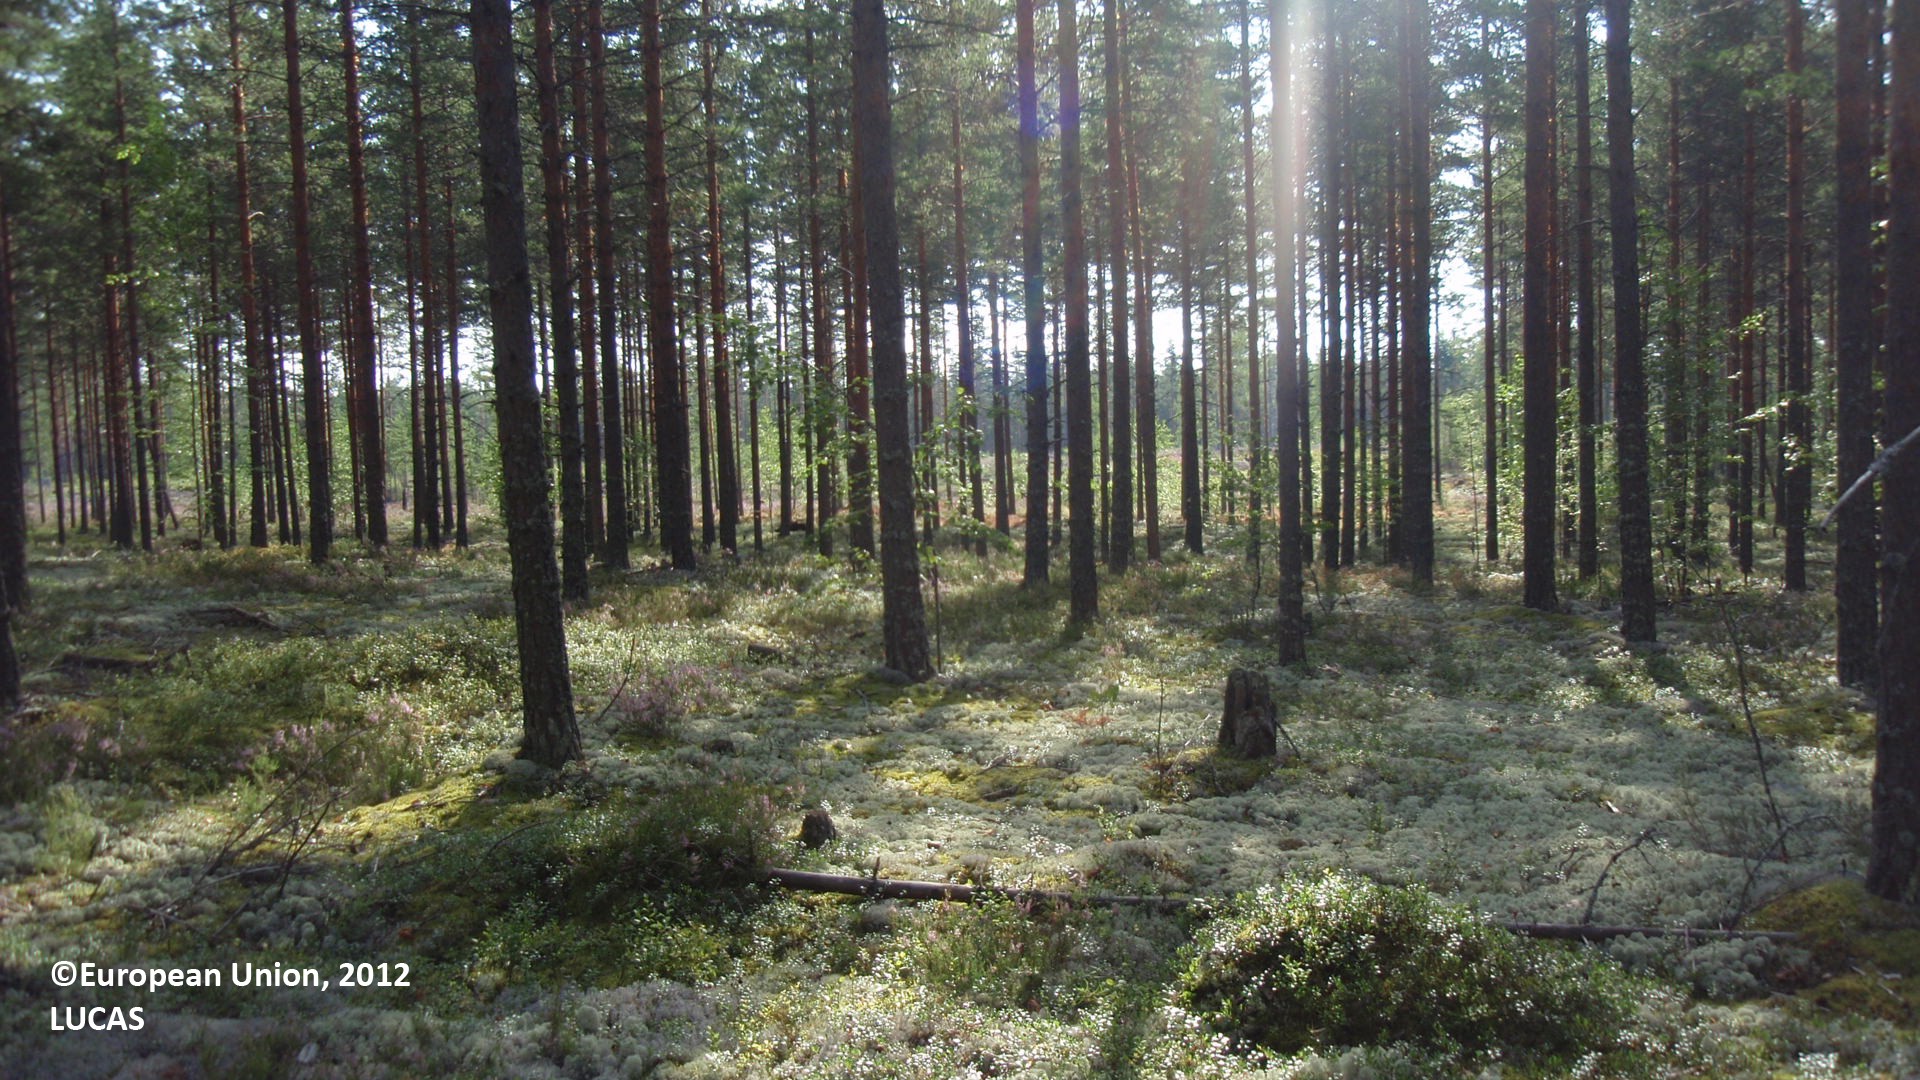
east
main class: Woodland
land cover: Pine dominated coniferous woodland
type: boreal forest
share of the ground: 50 - 75 %
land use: Forestry
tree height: > 5 m
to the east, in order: Pine dominated coniferous woodland; Shrubland with sparse tree cover; Electric lines; Shrubland with sparse tree cover; Ditches and canals; Paved roads, cycling and walking lanes; Ditches and canals; Shrubland with sparse tree cover
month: August
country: FI
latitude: 61.2654
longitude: 28.0427
